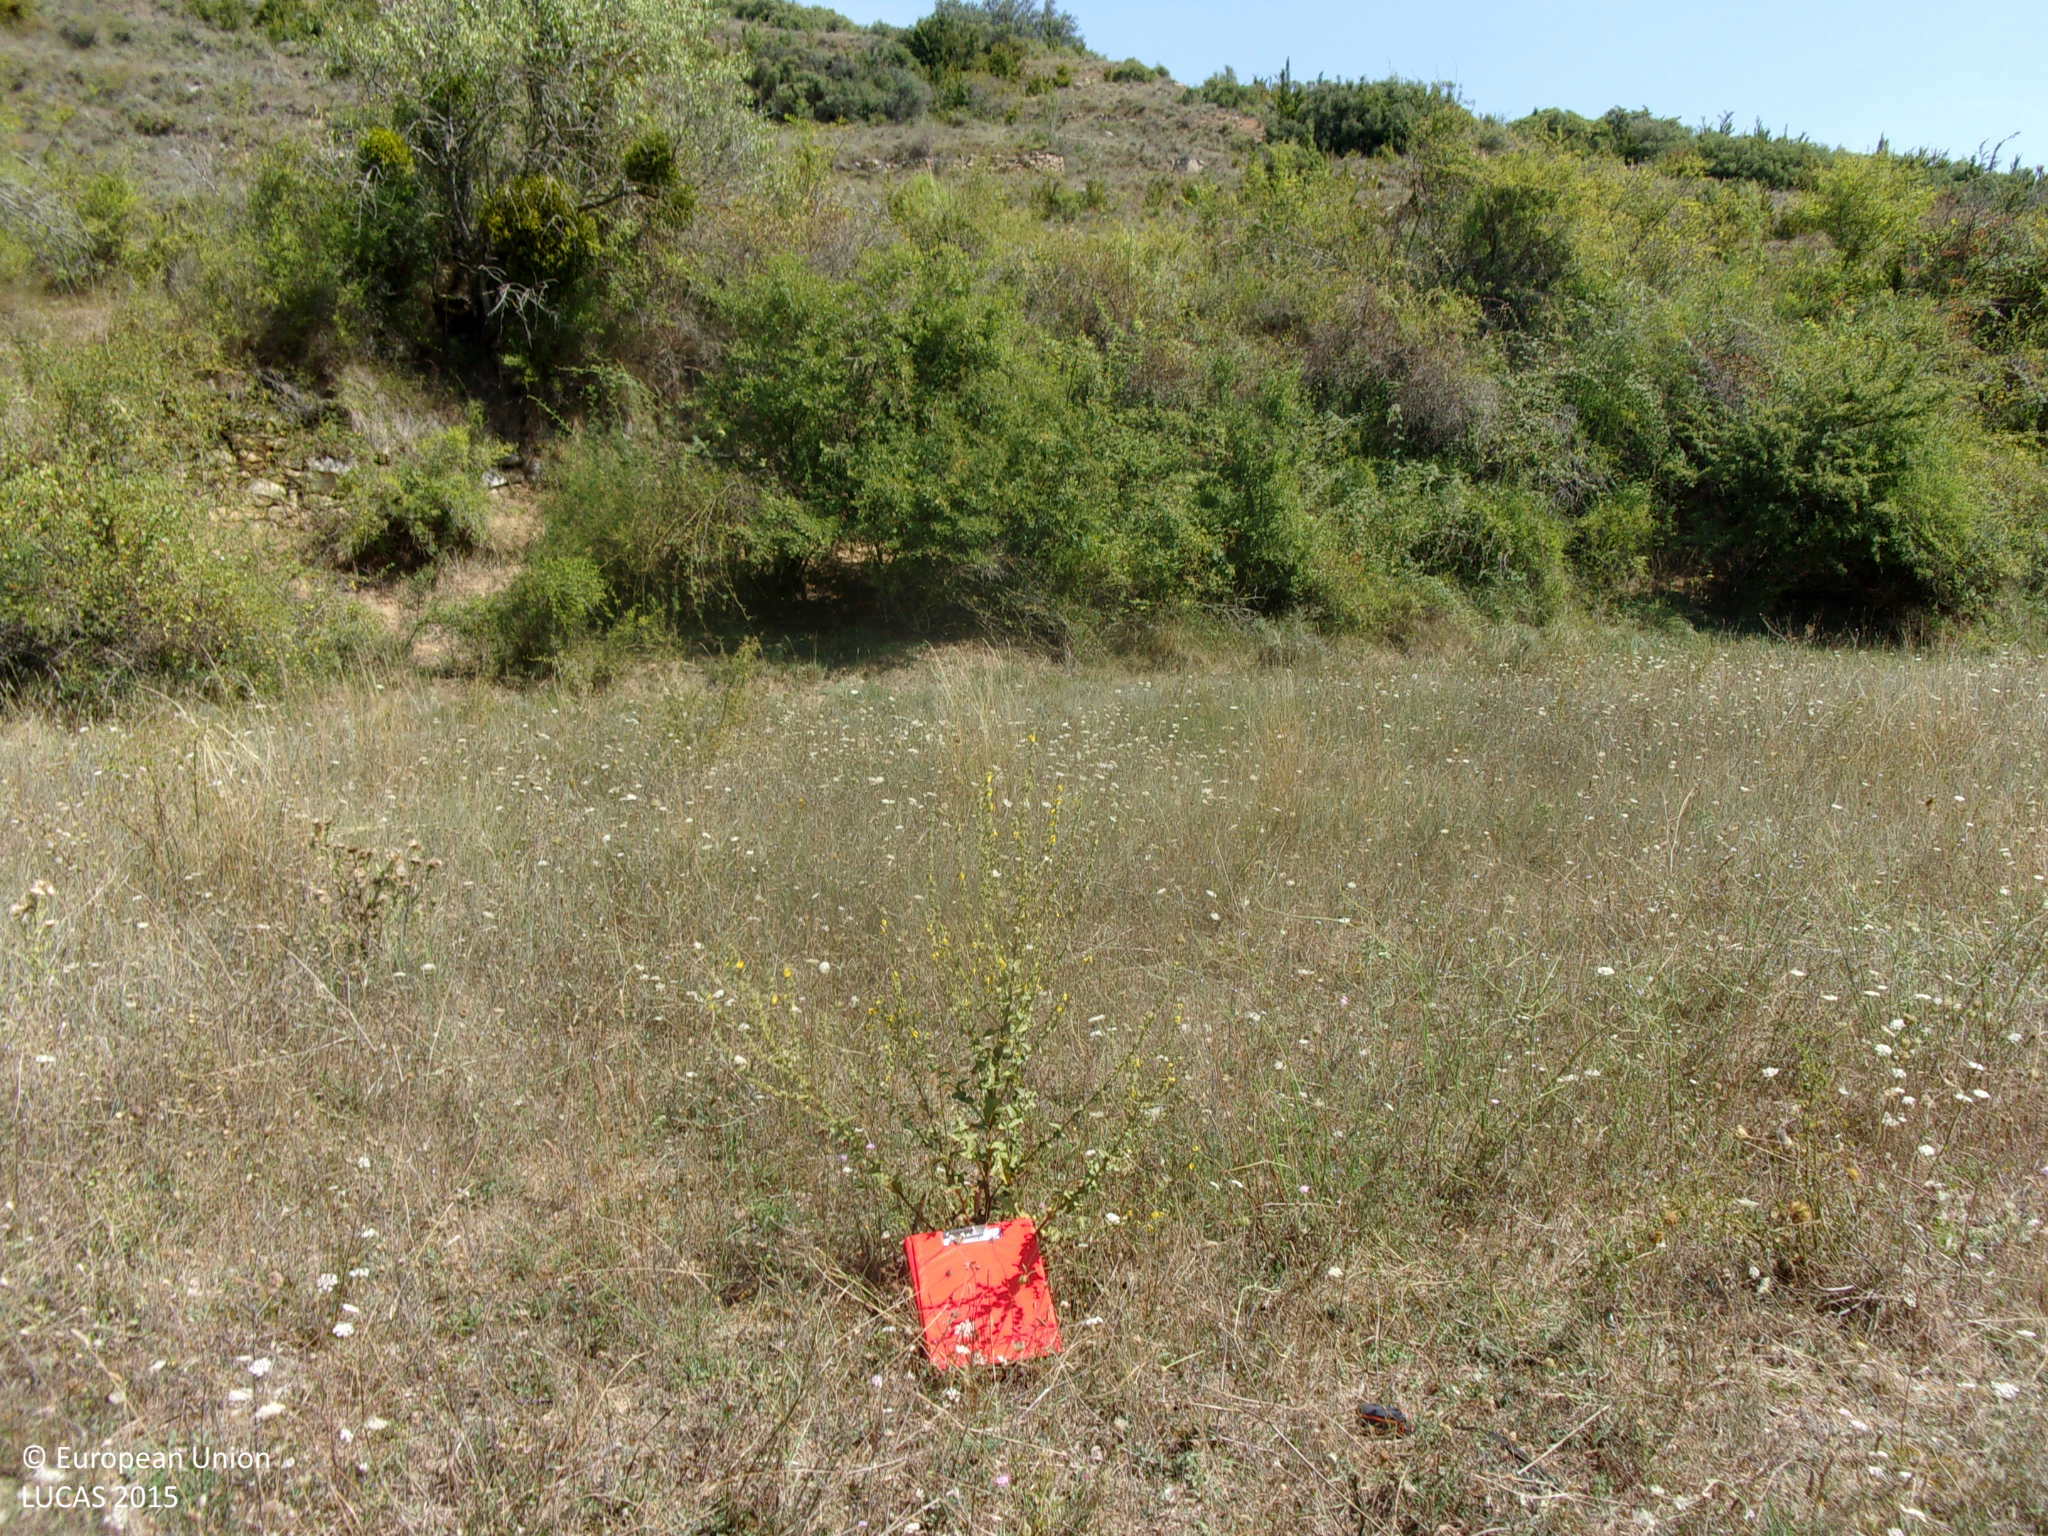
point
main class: Grassland
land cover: Spontaneously vegetated surfaces
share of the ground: > 75 %
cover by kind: herbaceous plants 100 %
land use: Abandoned areas
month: August
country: ES
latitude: 42.4848
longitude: -1.2122
